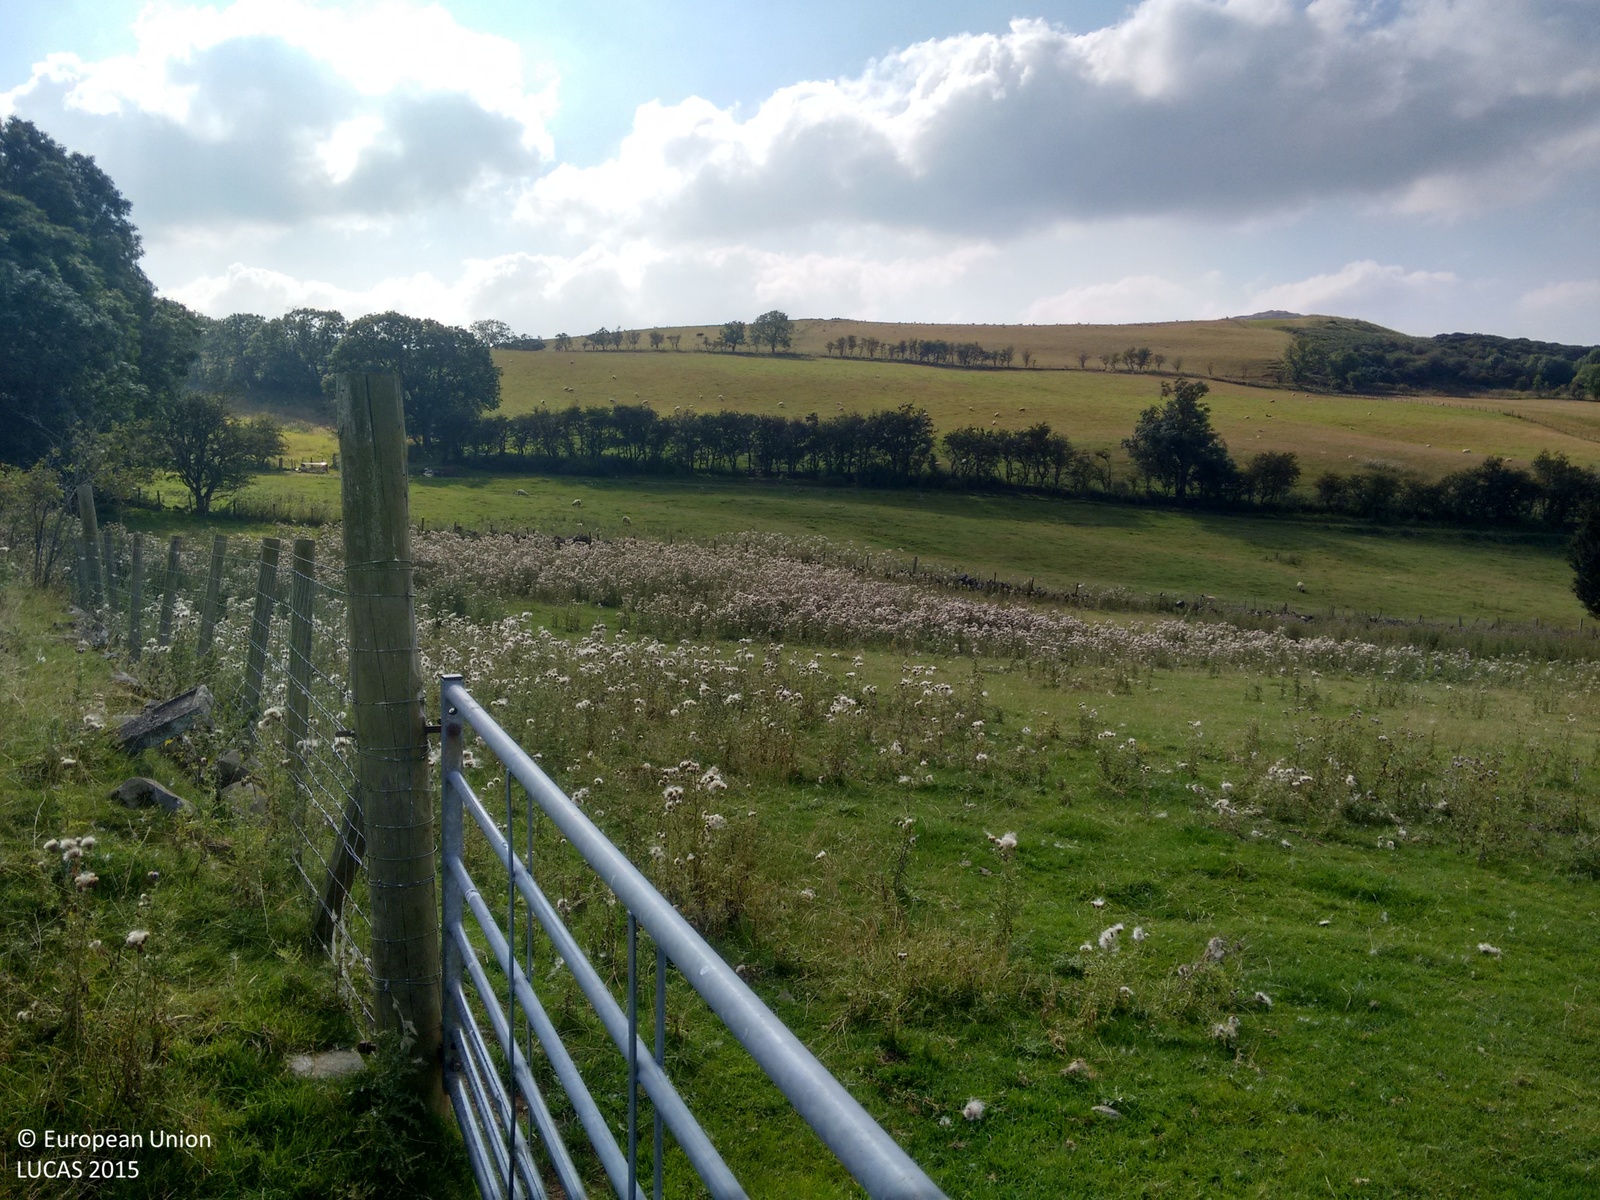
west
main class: Grassland
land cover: Grassland without tree/shrub cover
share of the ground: > 75 %
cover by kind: herbaceous plants 100 %
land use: Agriculture (excluding fallow land and kitchen gardens)
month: September
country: GB
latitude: 55.1239
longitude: -4.9303
